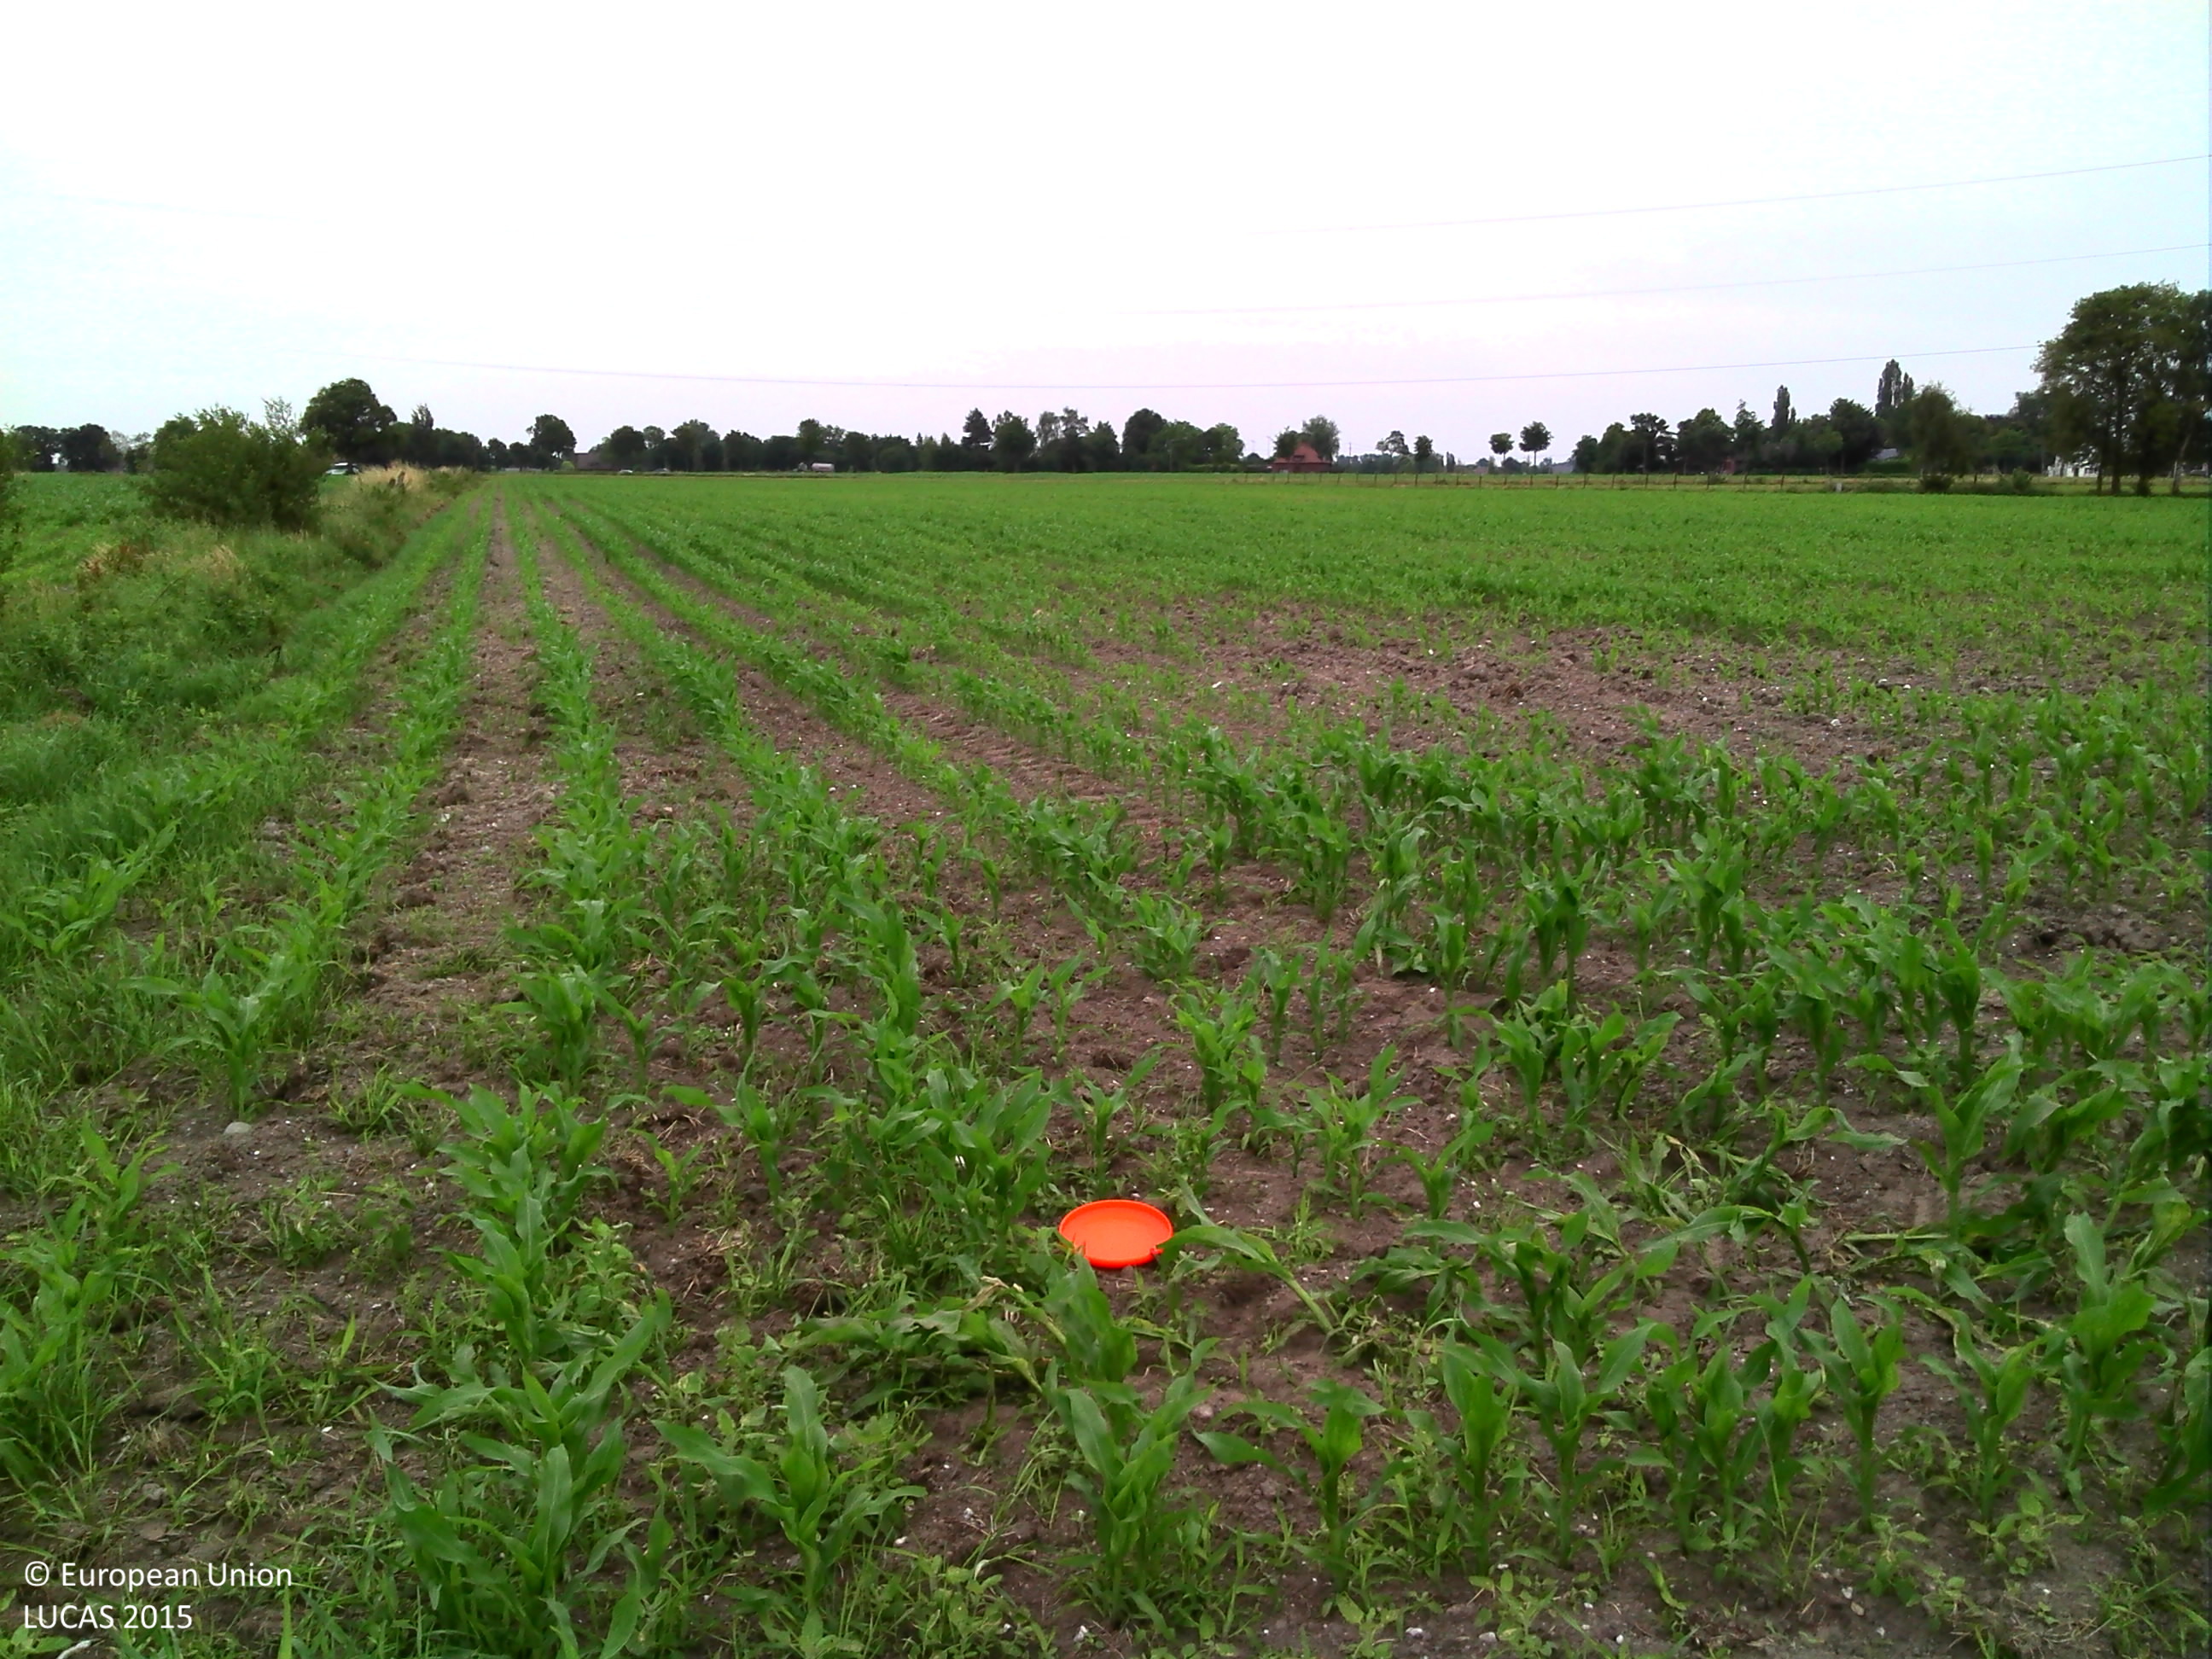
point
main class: Cropland
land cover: Maize
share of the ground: 10 - 25 %
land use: Agriculture (excluding fallow land and kitchen gardens)
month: June
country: BE
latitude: 51.1463
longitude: 5.6671
